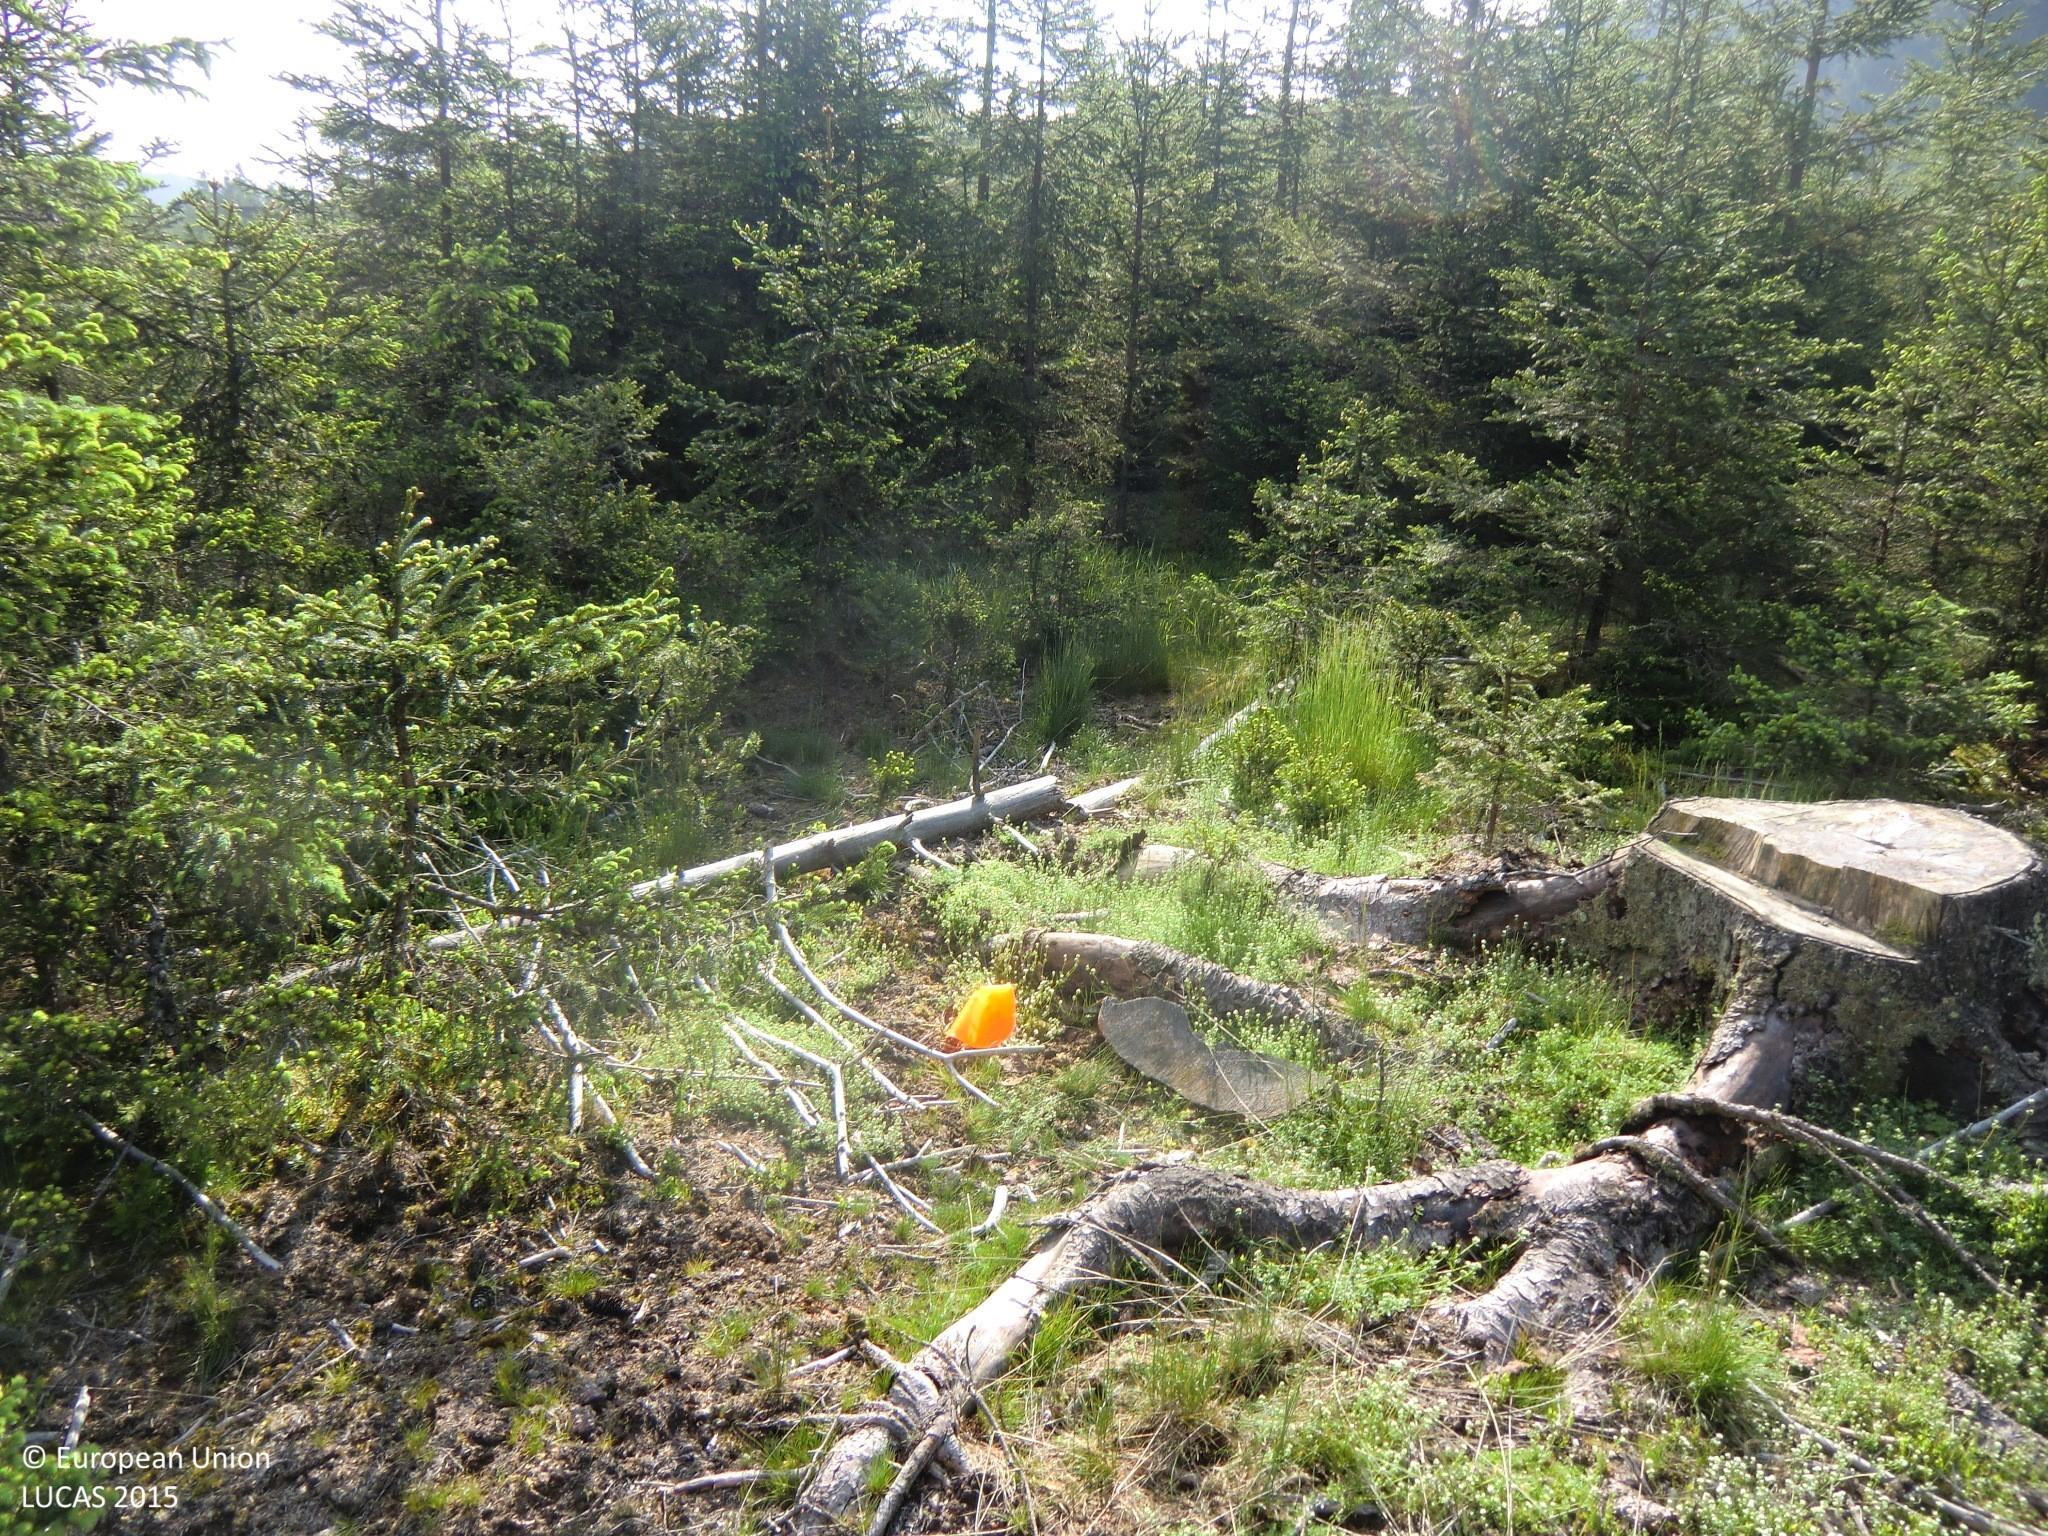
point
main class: Woodland
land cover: Spruce dominated coniferous woodland
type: hemiboreal forest and nemoral coniferous forest and mixed broadleaved-coniferous forest
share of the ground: 50 - 75 %
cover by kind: coniferous forest trees 60 %, herbaceous plants 20 %, lichens and mosses 10 %, unconsolidated bare surface 10 %
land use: Forestry
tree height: < 5 m
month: June
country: AT
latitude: 48.5523
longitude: 14.7836
